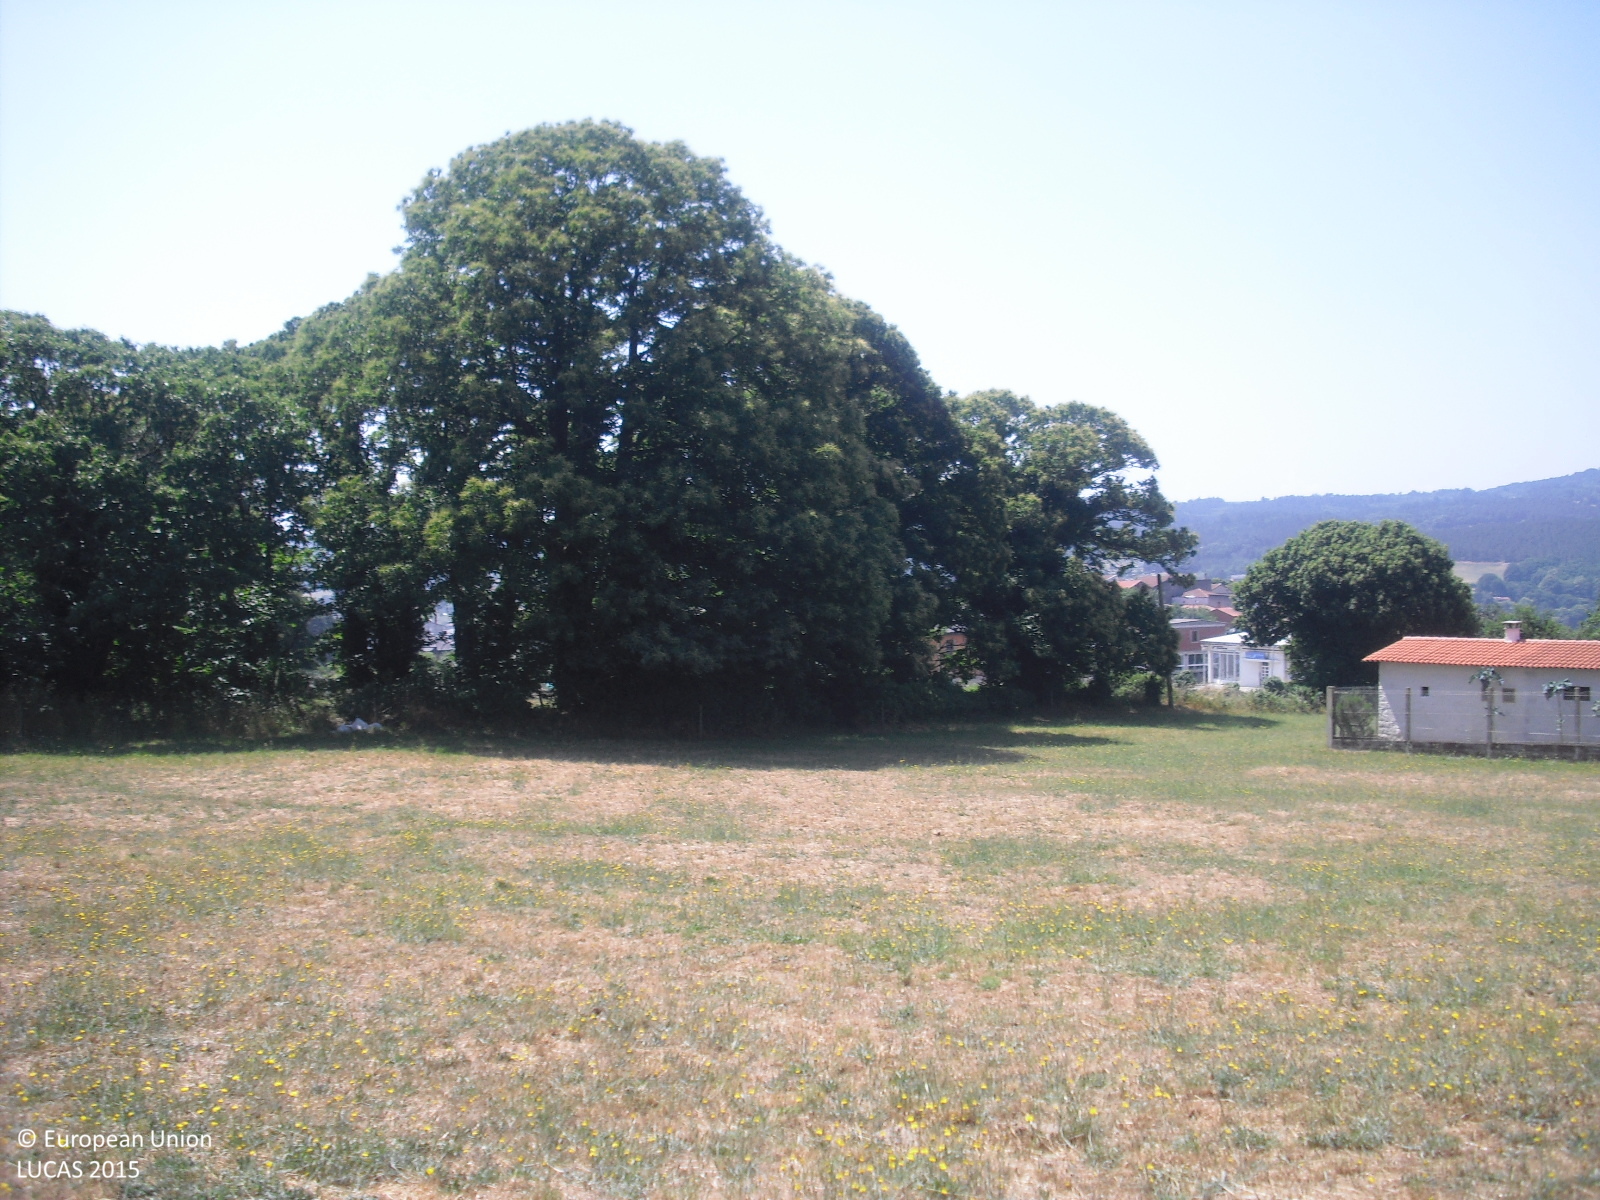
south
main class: Cropland
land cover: Temporary grasslands
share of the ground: > 75 %
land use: Agriculture (excluding fallow land and kitchen gardens)
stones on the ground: 25 - 50 %
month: June
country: ES
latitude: 42.6176
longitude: -7.7678
